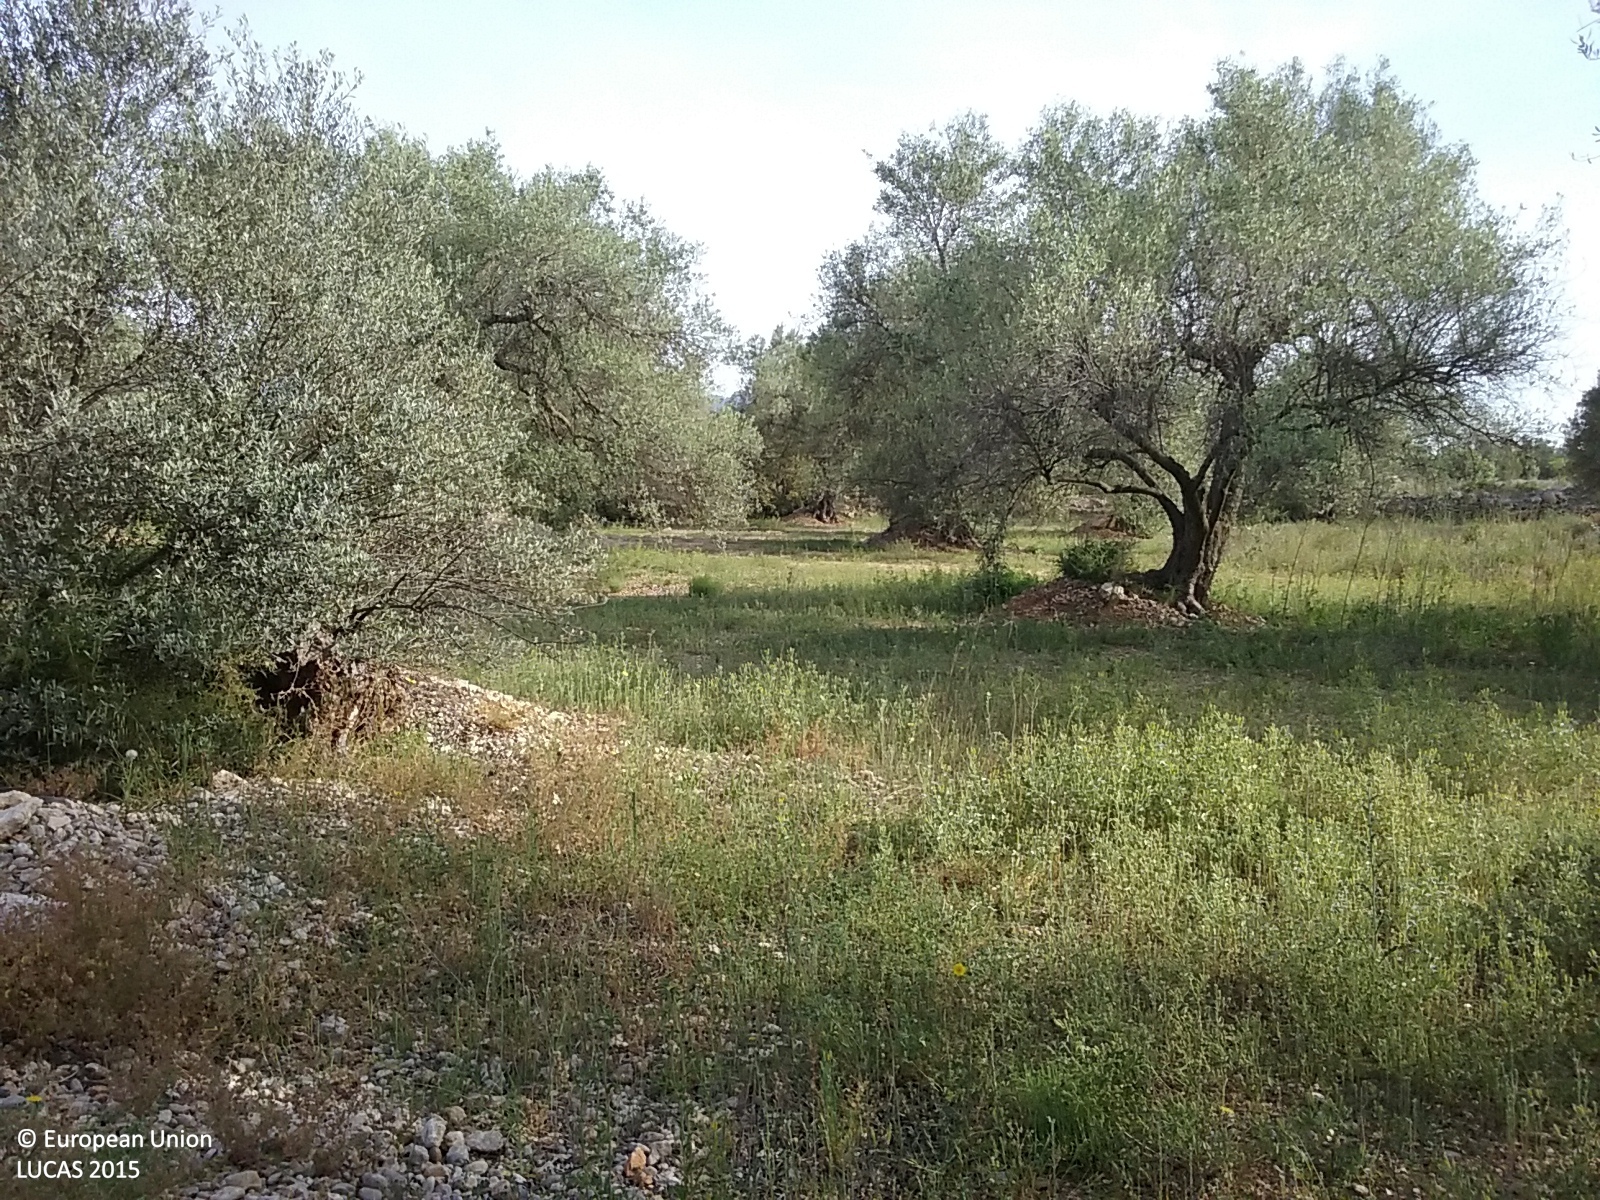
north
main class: Cropland
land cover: Olive groves
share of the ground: 25 - 50 %
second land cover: Grassland without tree/shrub cover
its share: > 75 %
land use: Agriculture (excluding fallow land and kitchen gardens)
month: May
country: ES
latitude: 40.6065
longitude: 0.3154
